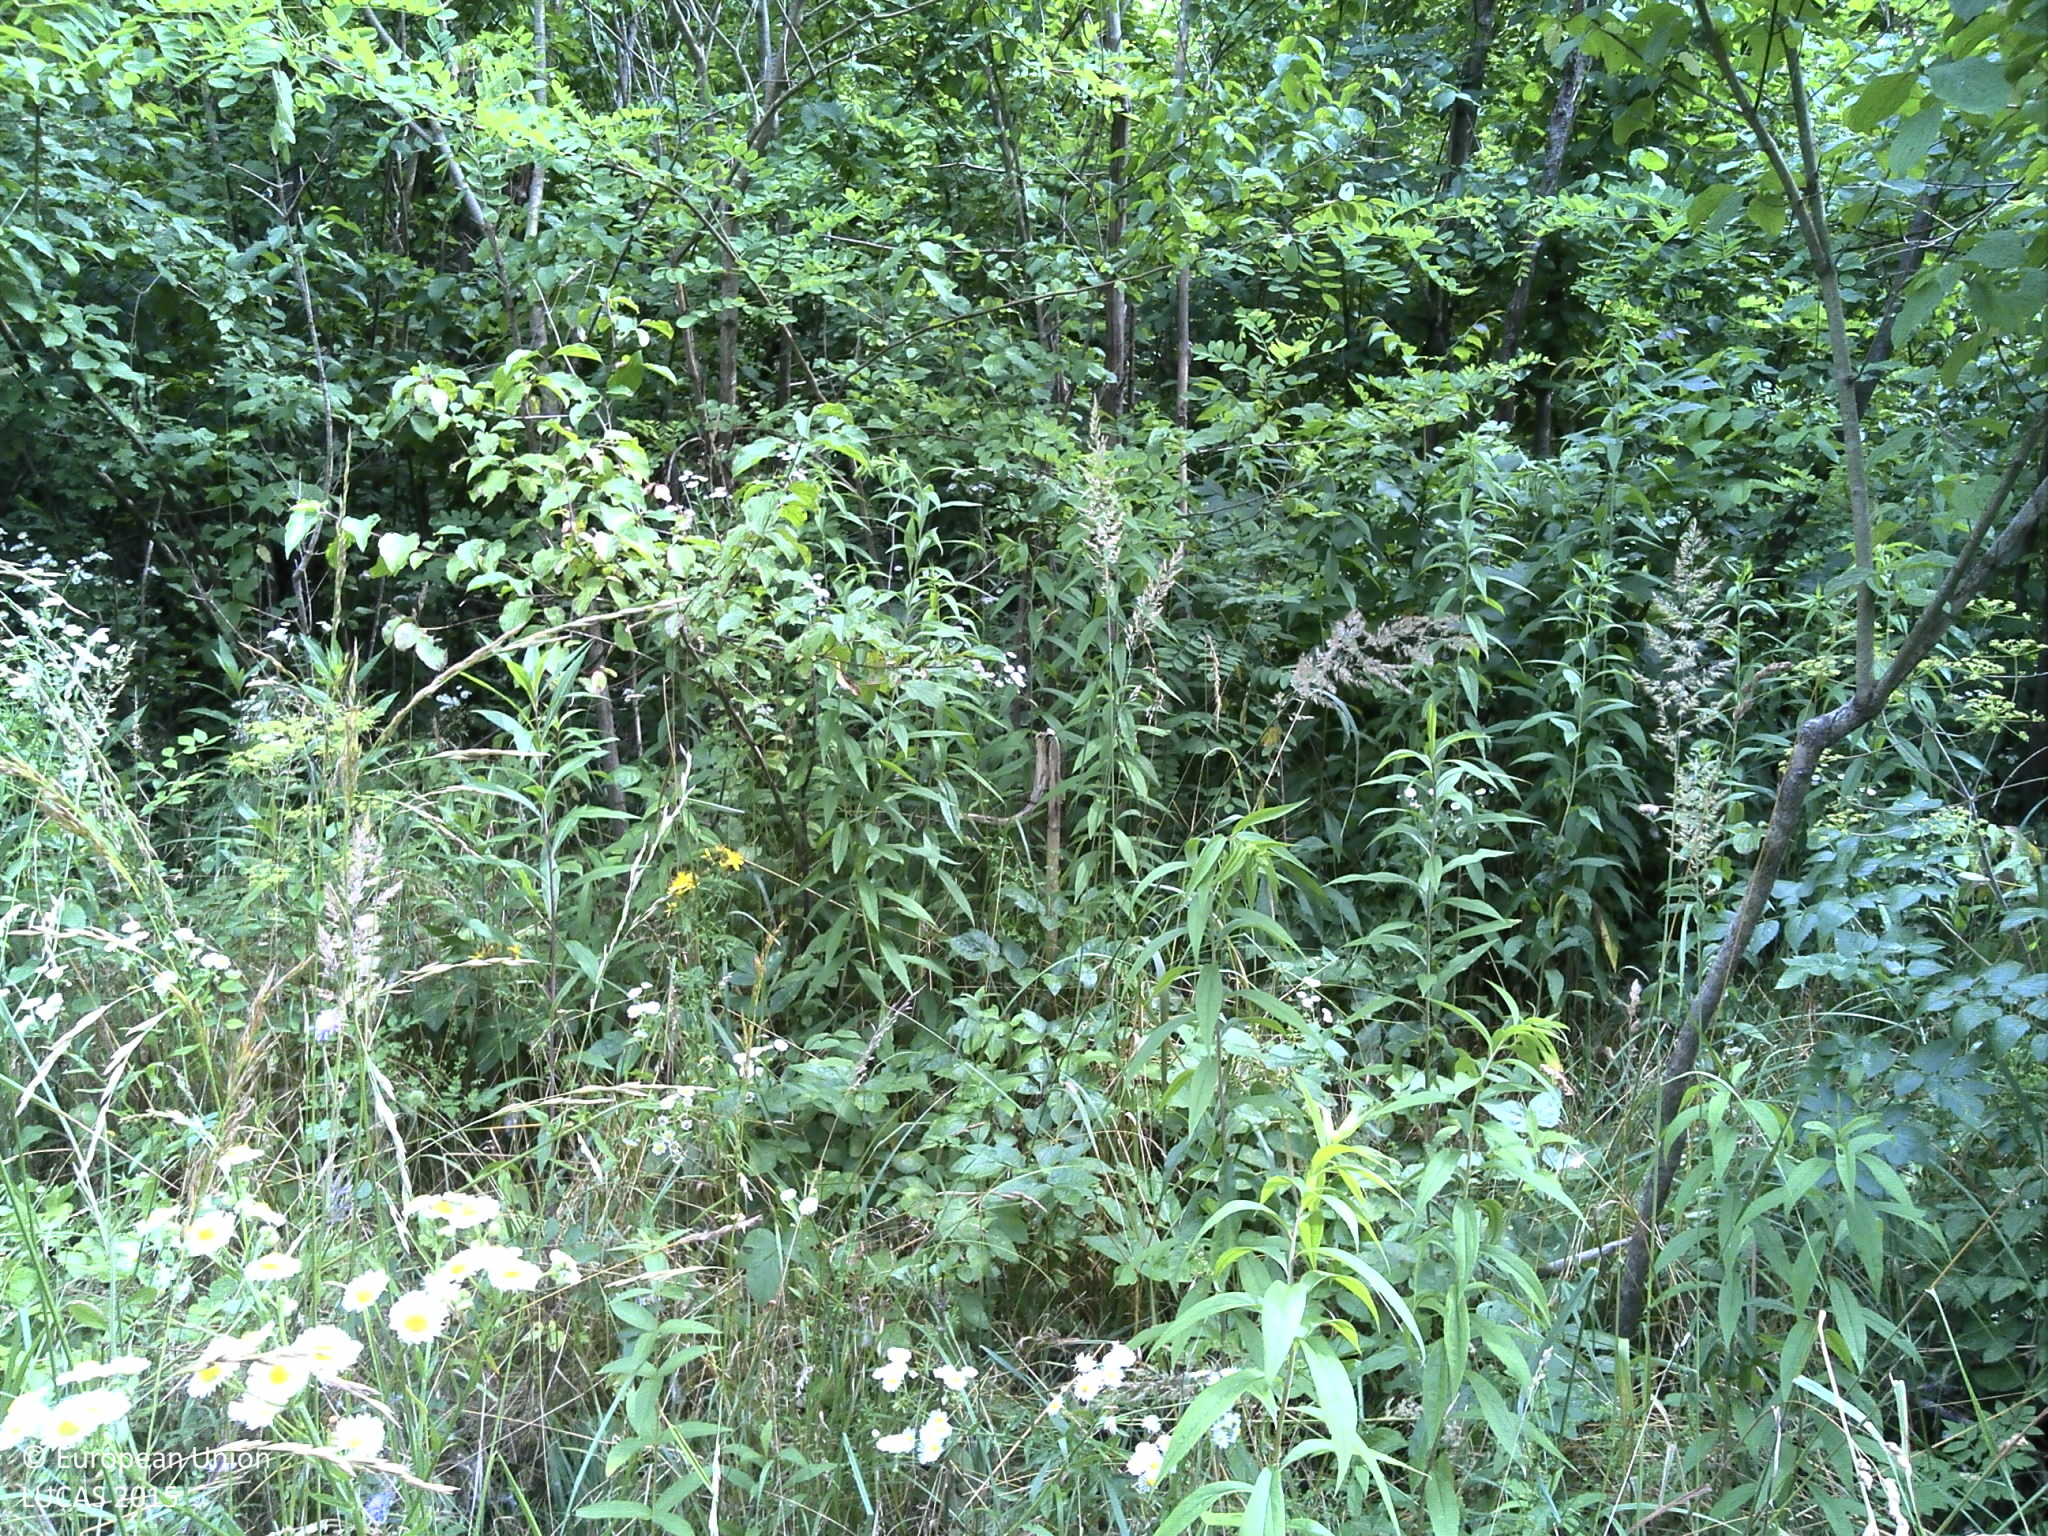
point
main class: Shrubland
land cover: Shrubland with sparse tree cover
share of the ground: > 75 %
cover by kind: shrubs 95 %, broadleaved forest trees 5 %
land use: Forestry
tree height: > 5 m
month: June
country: HR
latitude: 45.9557
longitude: 17.3179
